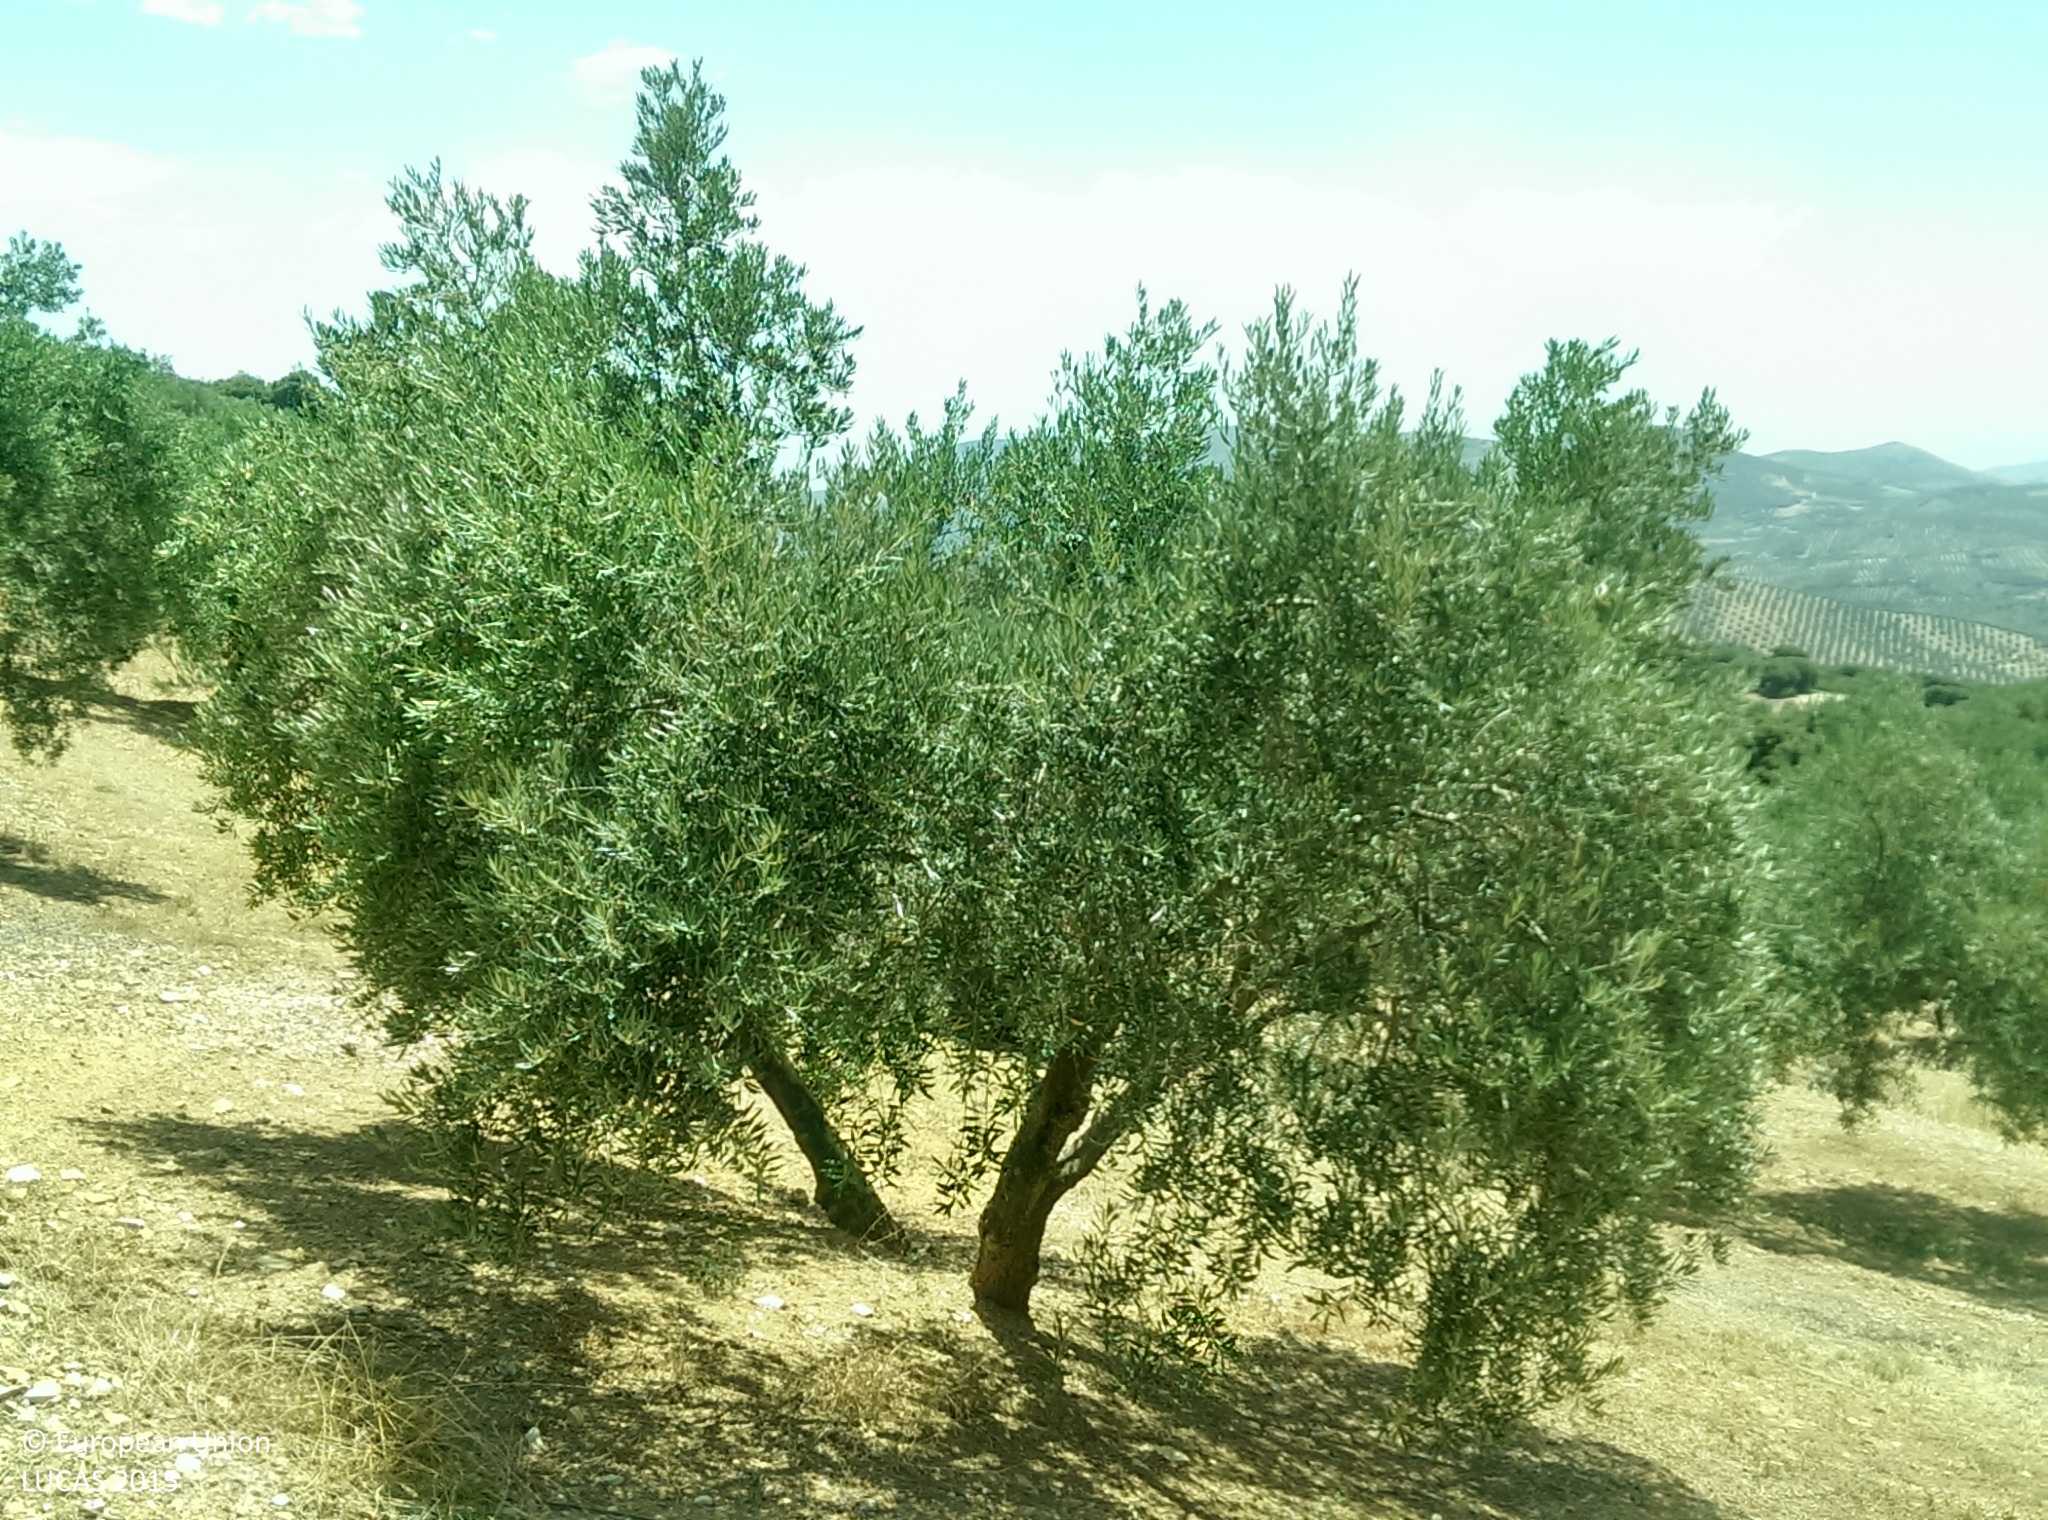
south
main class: Cropland
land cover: Olive groves
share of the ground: 50 - 75 %
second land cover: Spontaneously vegetated surfaces
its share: 10 - 25 %
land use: Agriculture (excluding fallow land and kitchen gardens)
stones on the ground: 10 - 25 %
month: July
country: ES
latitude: 37.4479
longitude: -3.7060
